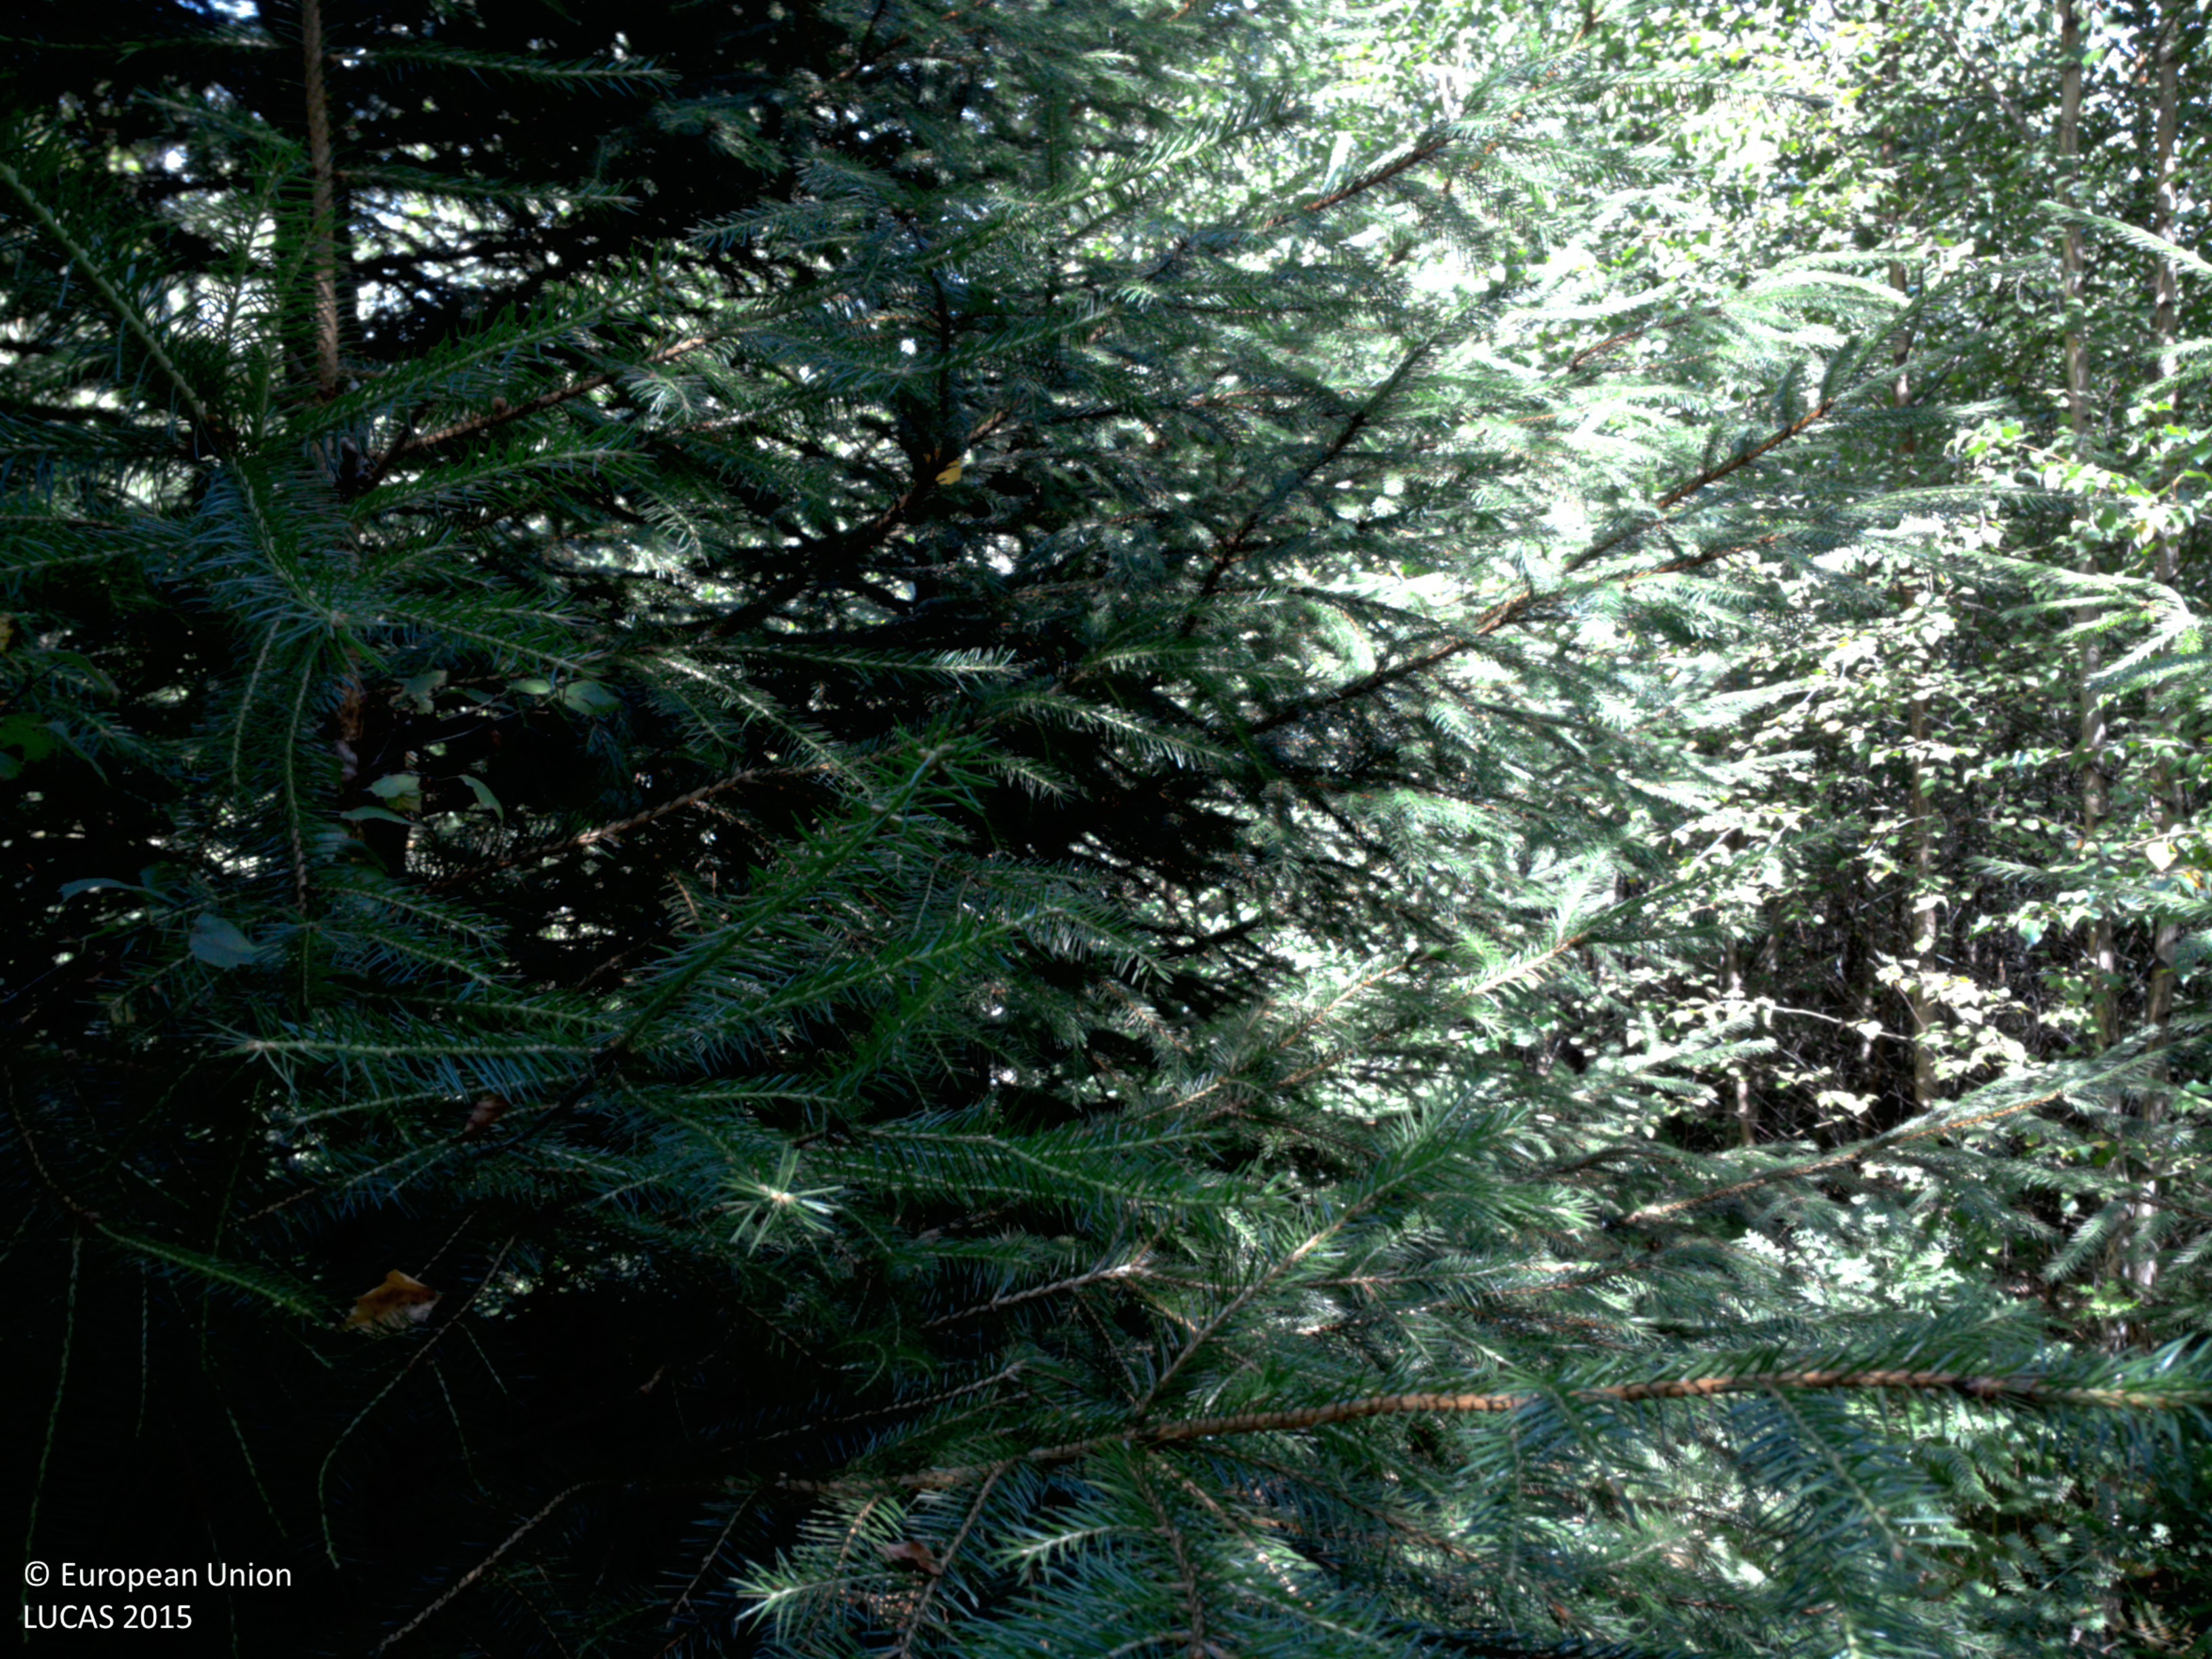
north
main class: Woodland
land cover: Spruce dominated mixed woodland
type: boreal forest
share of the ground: > 75 %
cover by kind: coniferous forest trees 60 %, broadleaved forest trees 30 %, shrubs 5 %, herbaceous plants 5 %
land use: Forestry
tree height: < 5 m
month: July
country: SE
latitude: 58.1362
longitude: 11.7460
